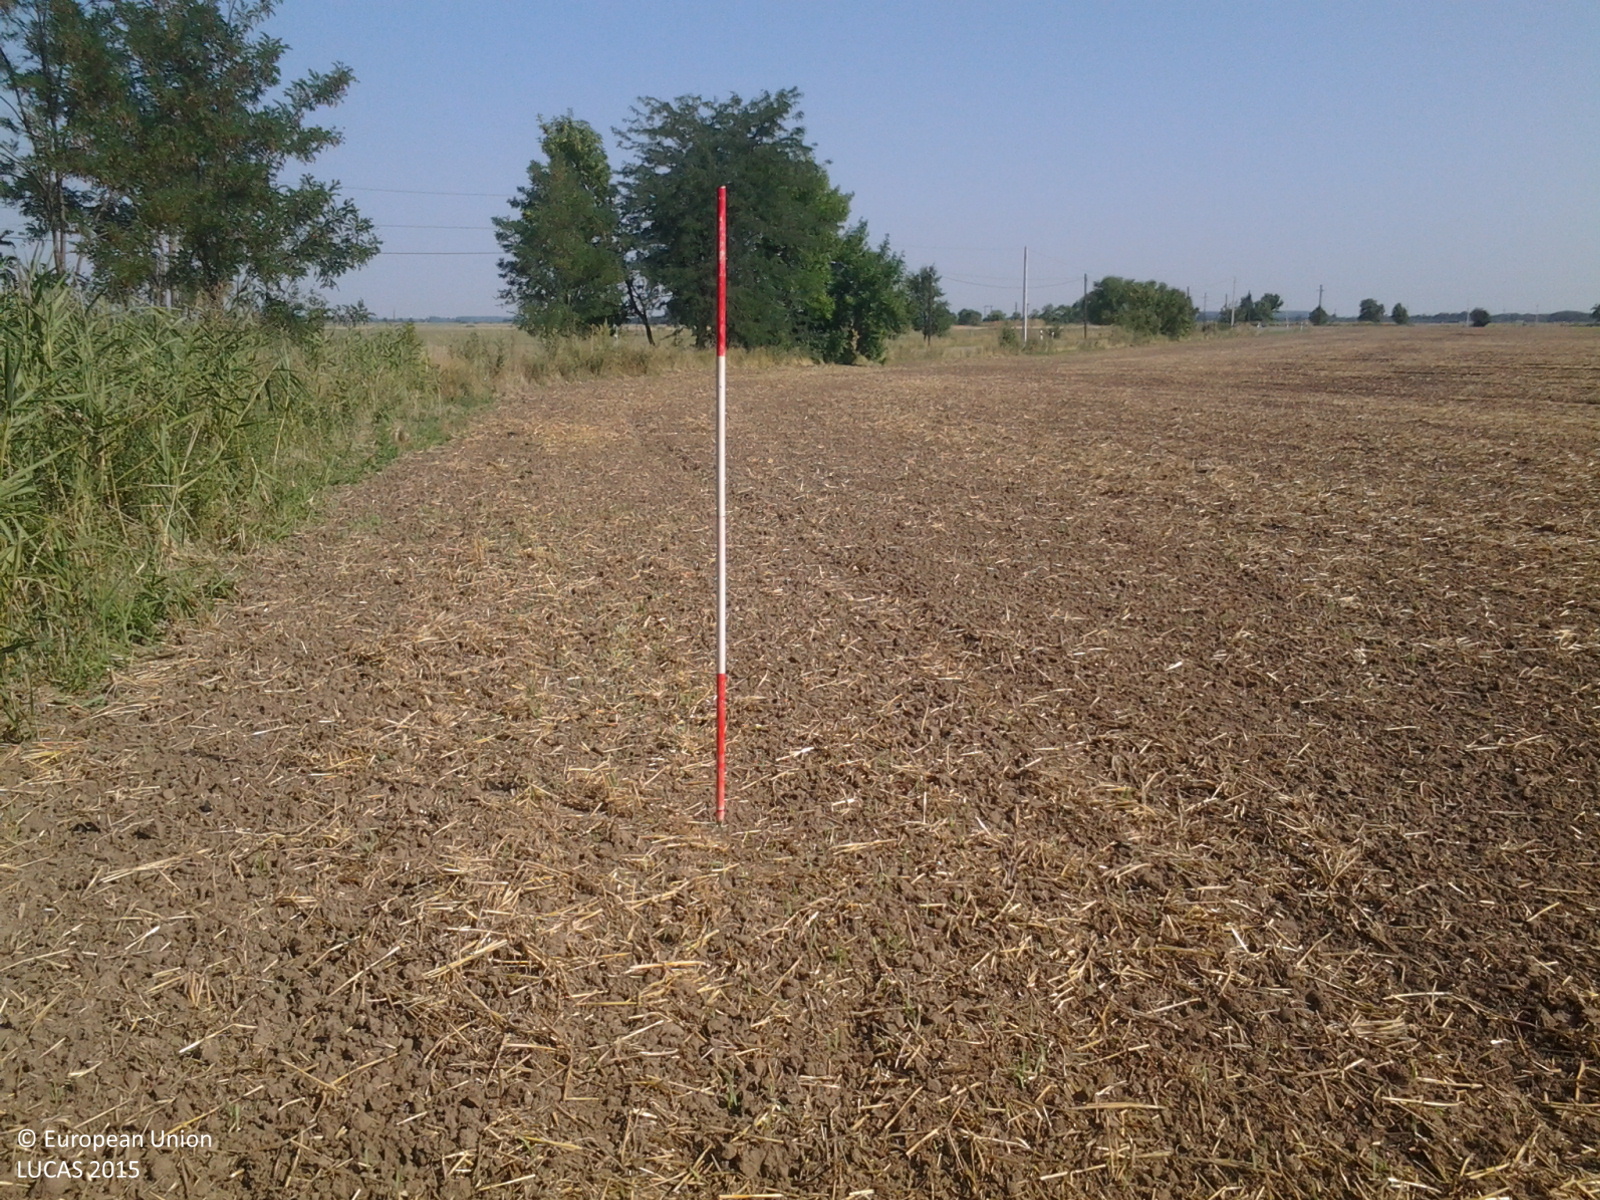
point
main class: Cropland
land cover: Common wheat
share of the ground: < 10 %
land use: Agriculture (excluding fallow land and kitchen gardens)
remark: Harvested field
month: August
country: HU
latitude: 46.9282
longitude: 21.5057
